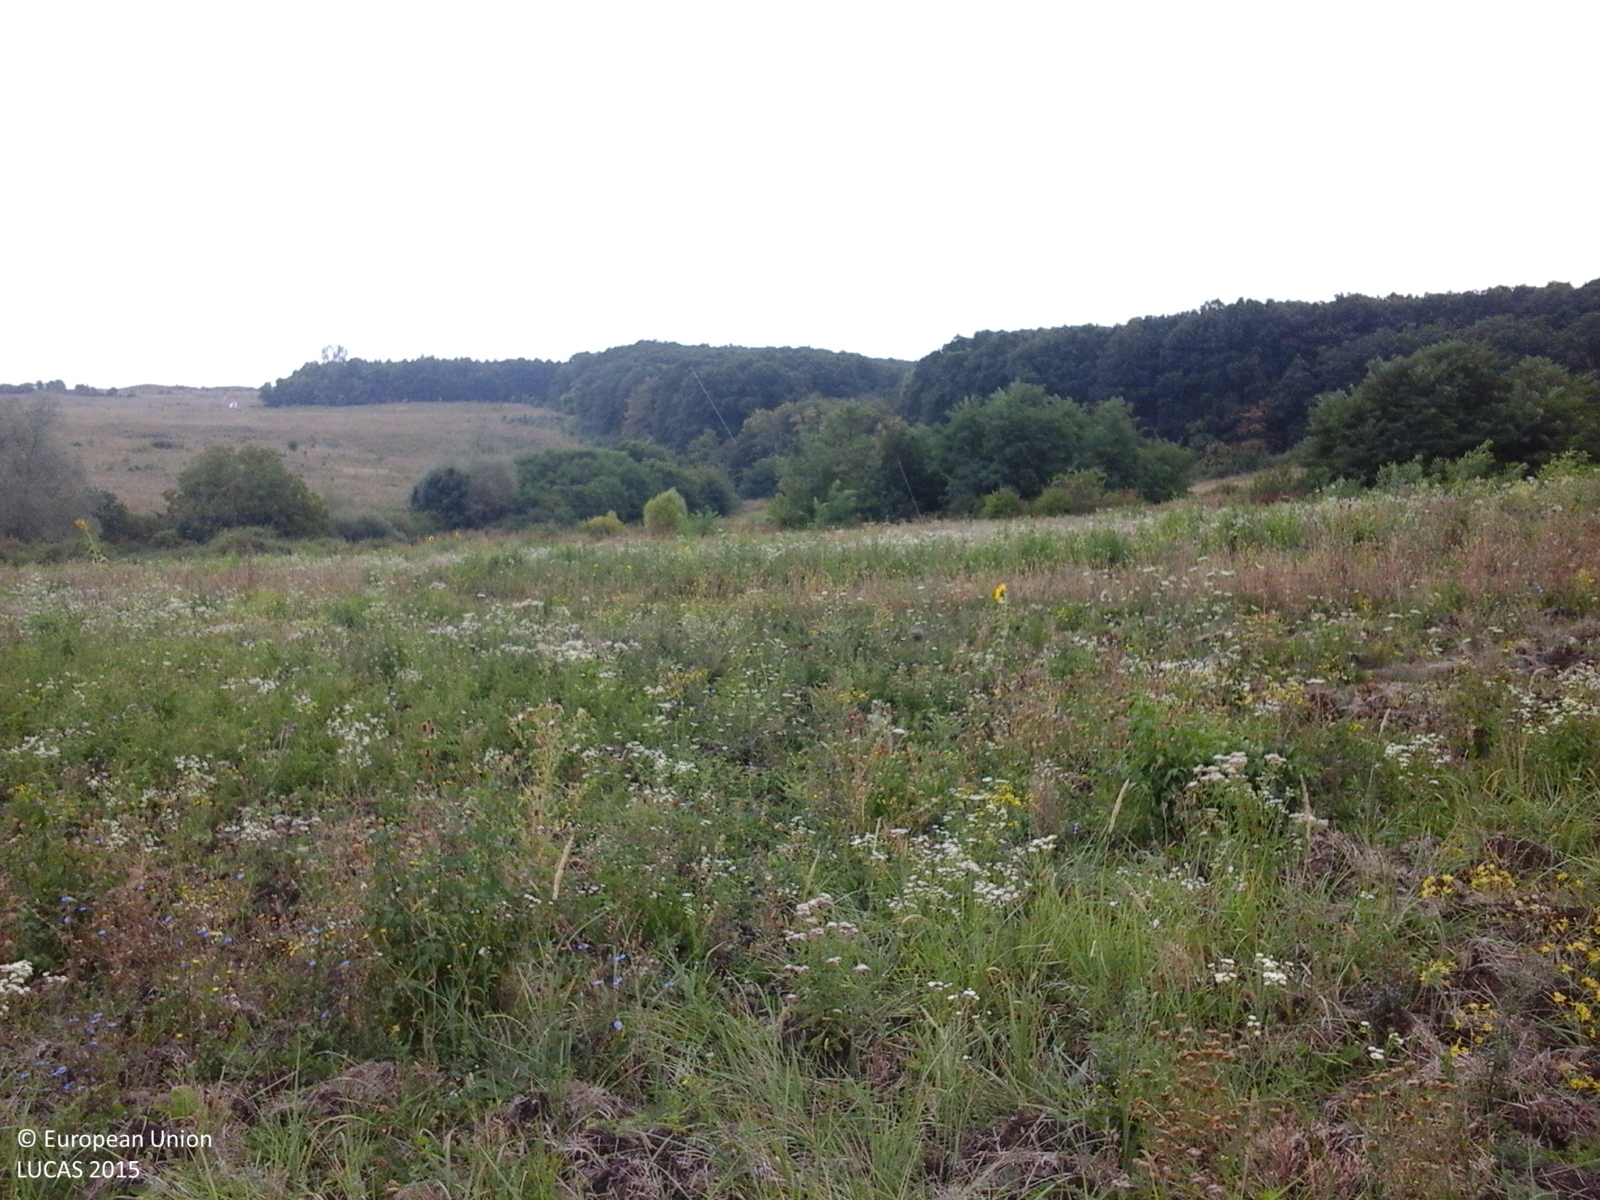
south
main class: Grassland
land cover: Spontaneously vegetated surfaces
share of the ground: > 75 %
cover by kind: herbaceous plants 100 %
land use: Fallow land
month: September
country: RO
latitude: 47.2577
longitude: 23.0815
